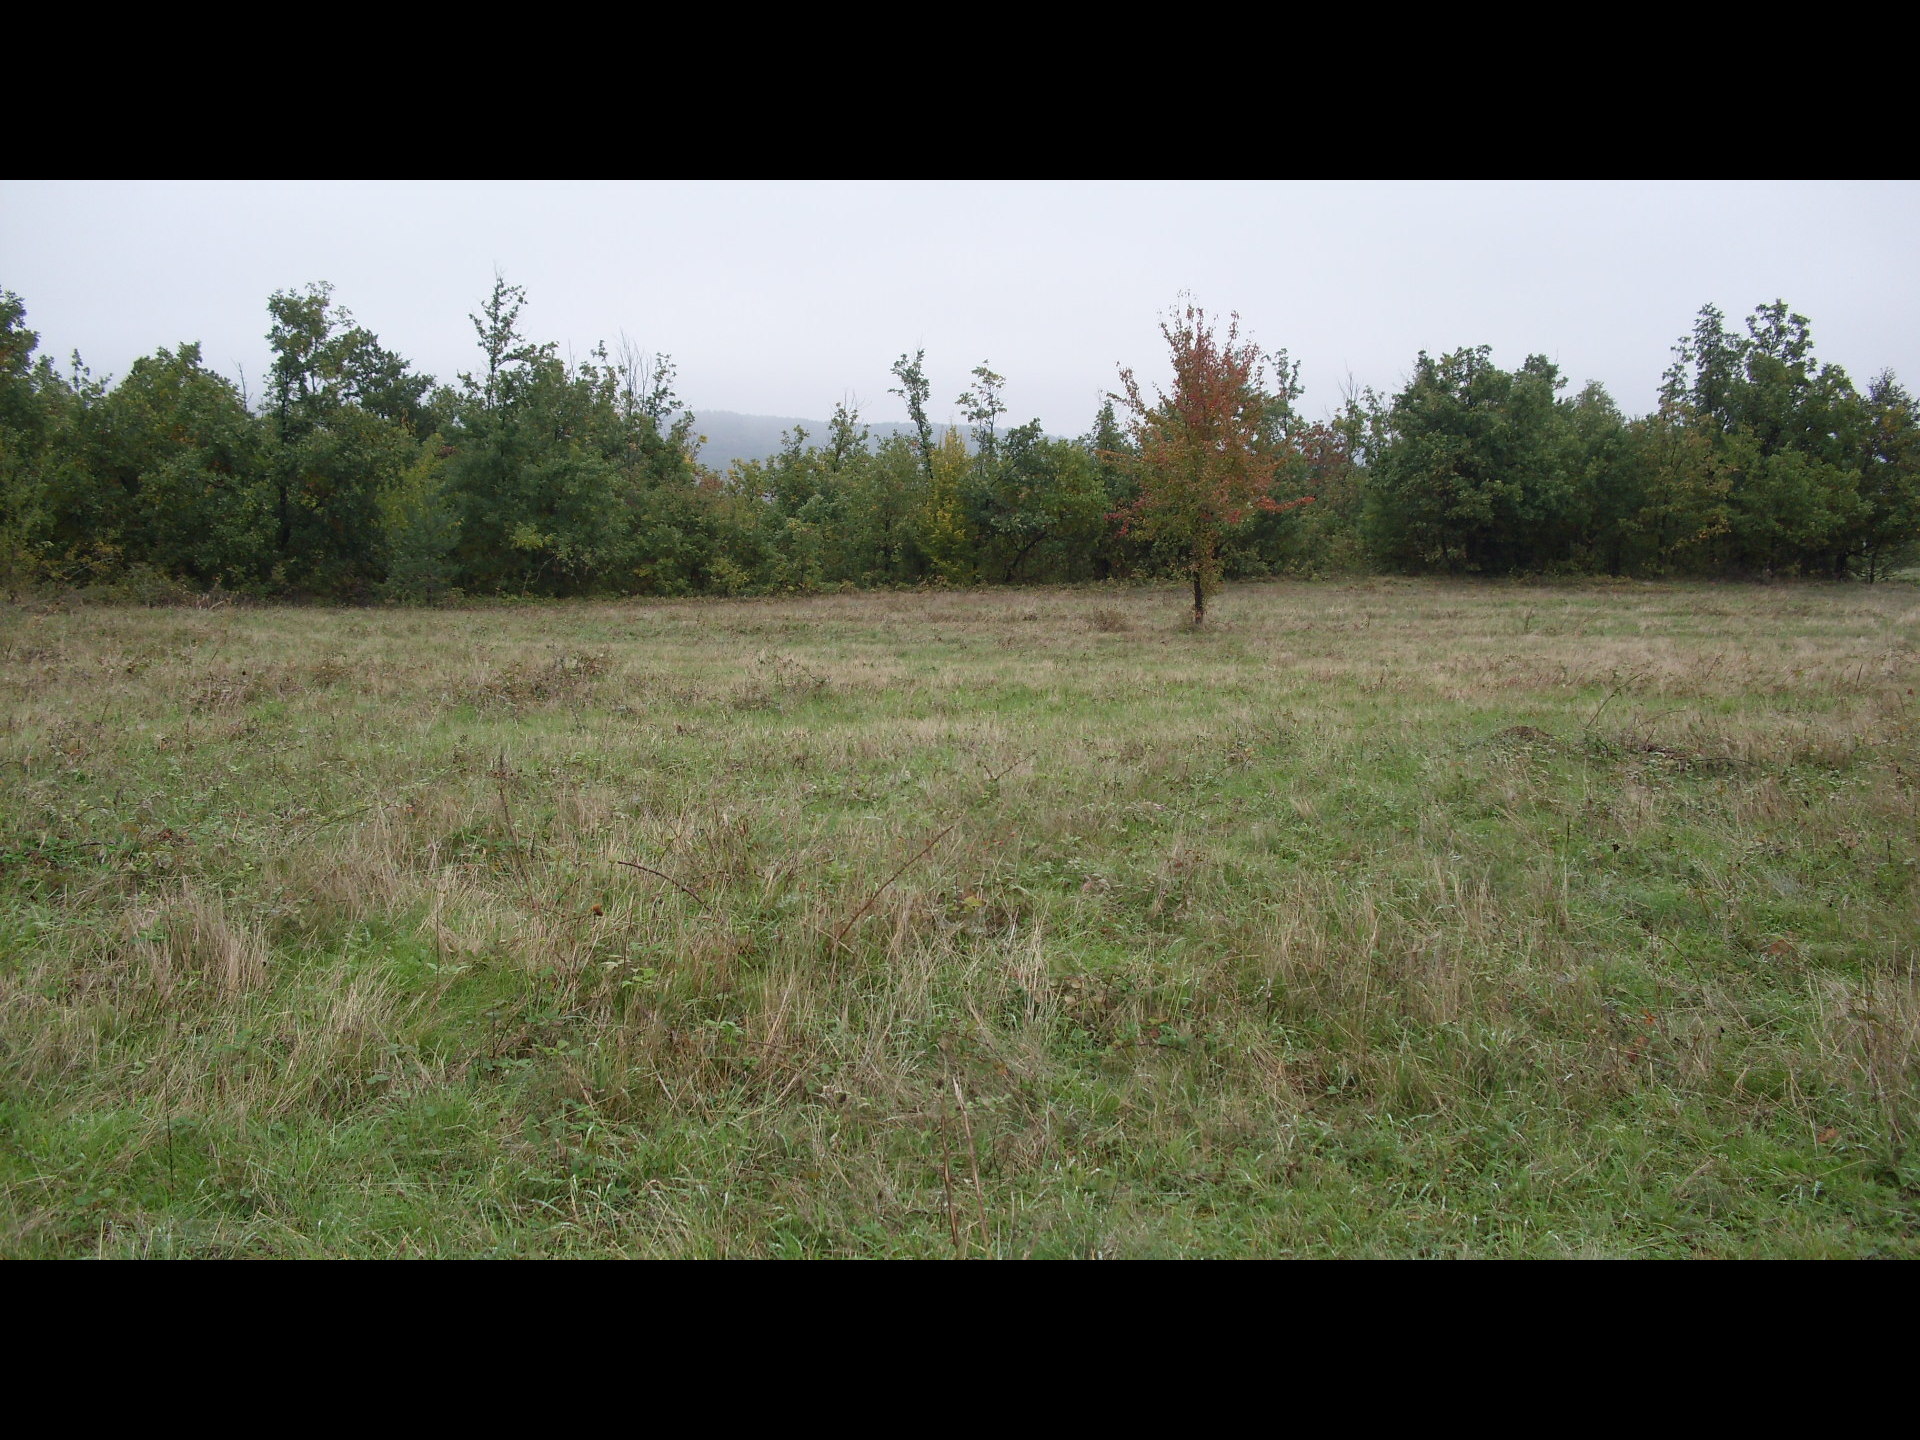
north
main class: Grassland
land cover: Grassland without tree/shrub cover
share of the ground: > 75 %
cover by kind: herbaceous plants 100 %
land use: Agriculture (excluding fallow land and kitchen gardens)
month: October
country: BG
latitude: 43.6352
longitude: 22.5890
